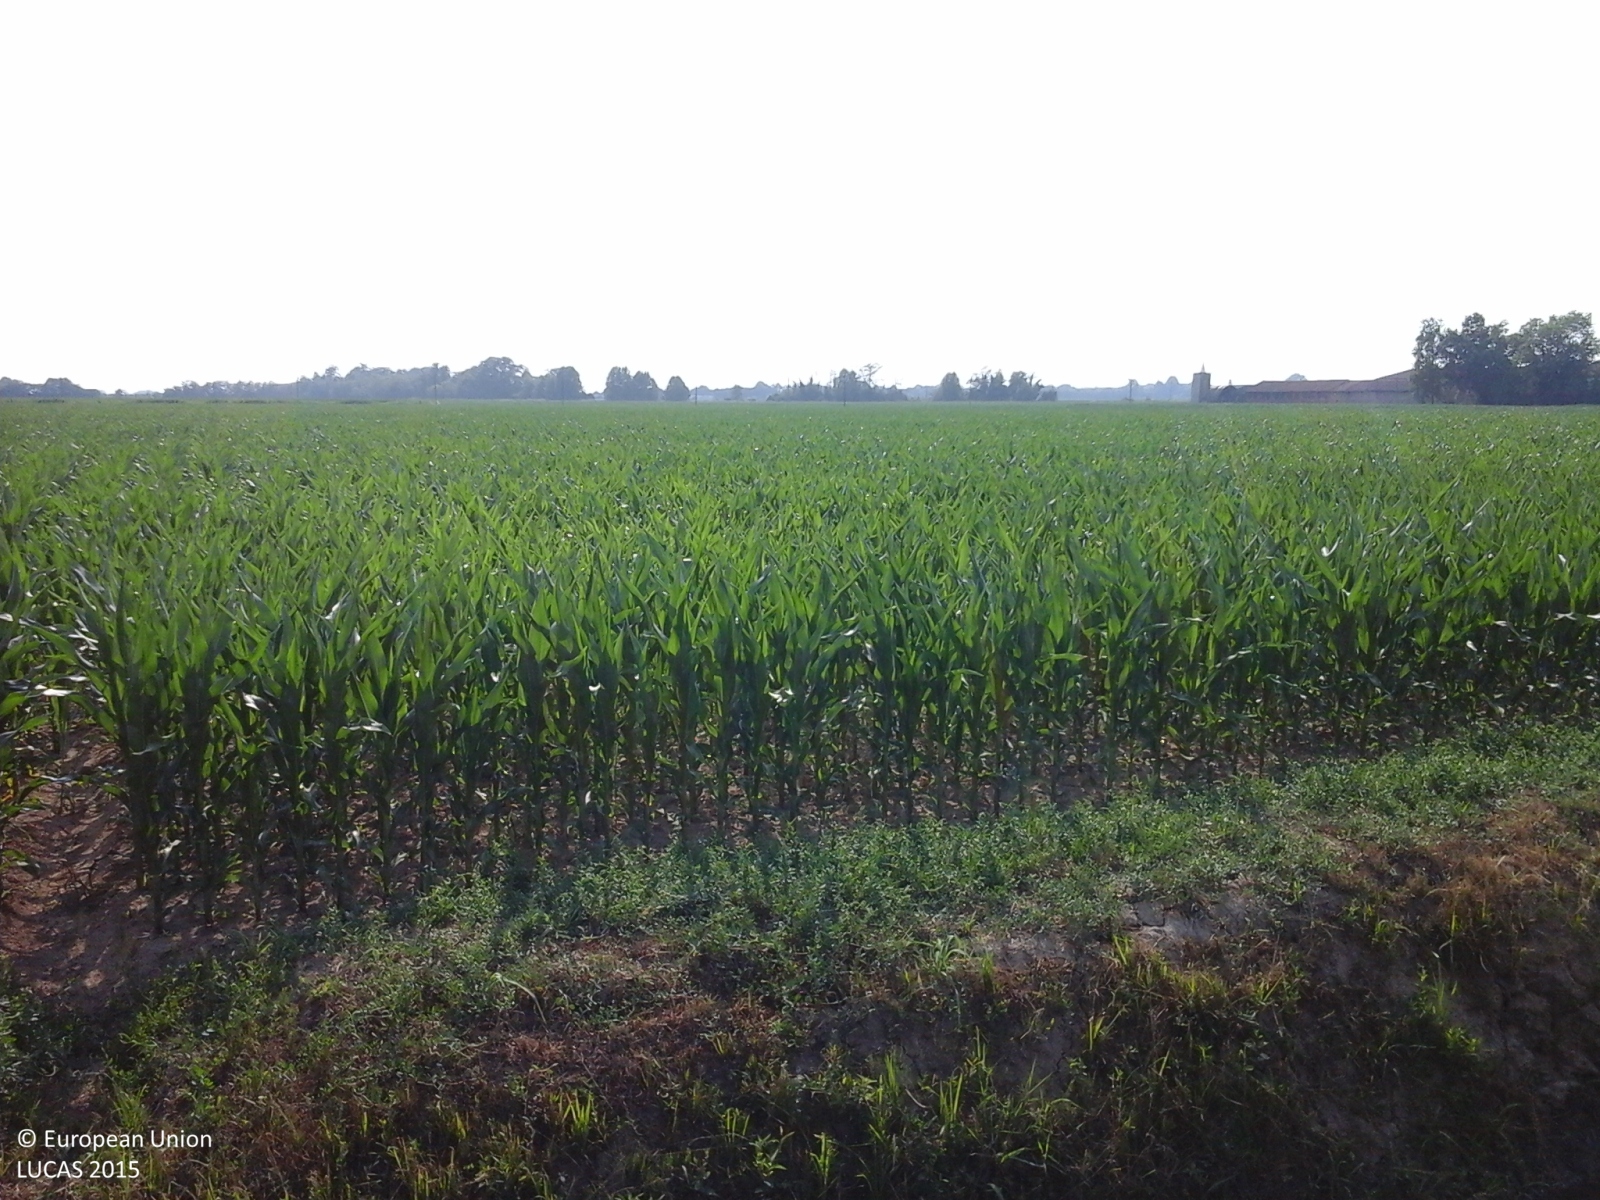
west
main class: Artificial land
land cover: Non built-up linear features
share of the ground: > 75 %
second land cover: Grassland without tree/shrub cover
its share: > 75 %
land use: Road transport
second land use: Agriculture (excluding fallow land and kitchen gardens)
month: June
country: IT
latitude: 45.1612
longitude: 9.6064
